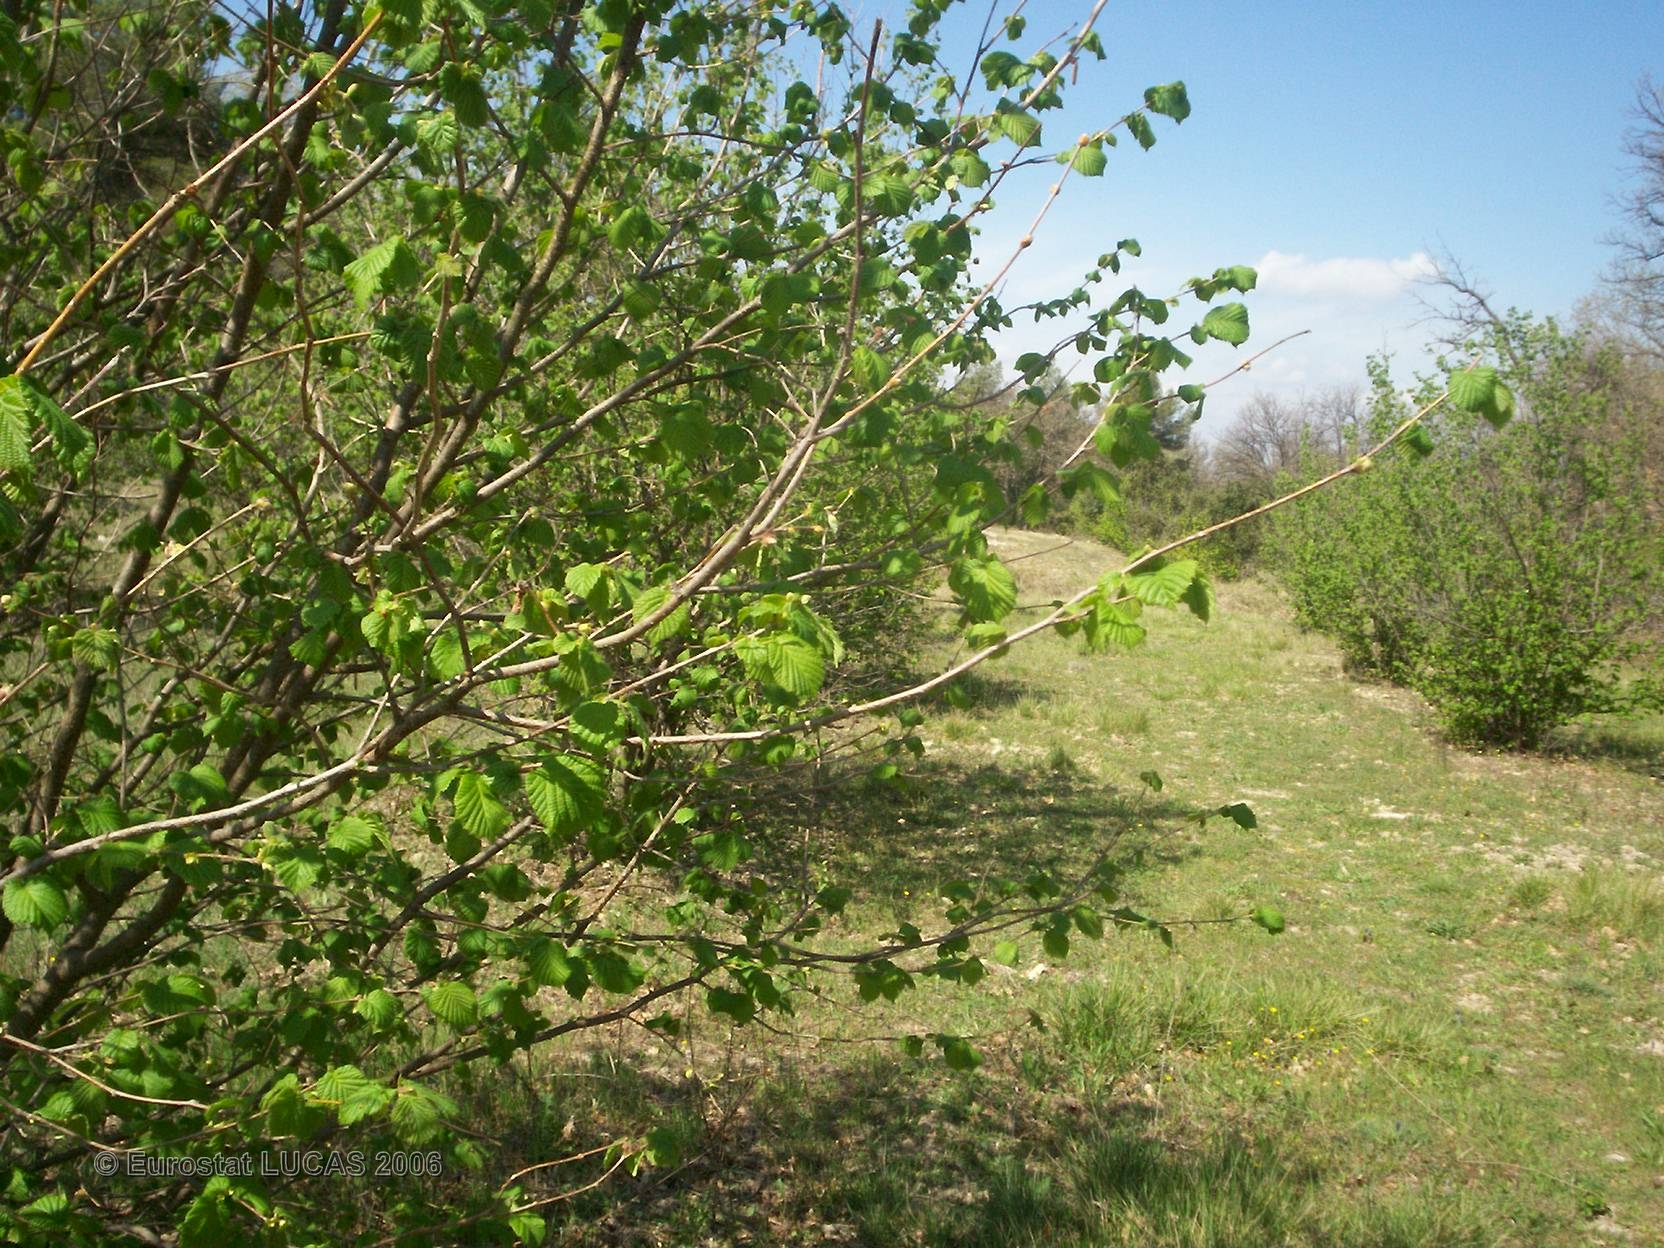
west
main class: Cropland
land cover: Nuts trees
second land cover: Grassland with sparse tree/shrub cover
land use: Agriculture (excluding fallow land and kitchen gardens)
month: April
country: FR
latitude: 43.5163
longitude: 5.5932
